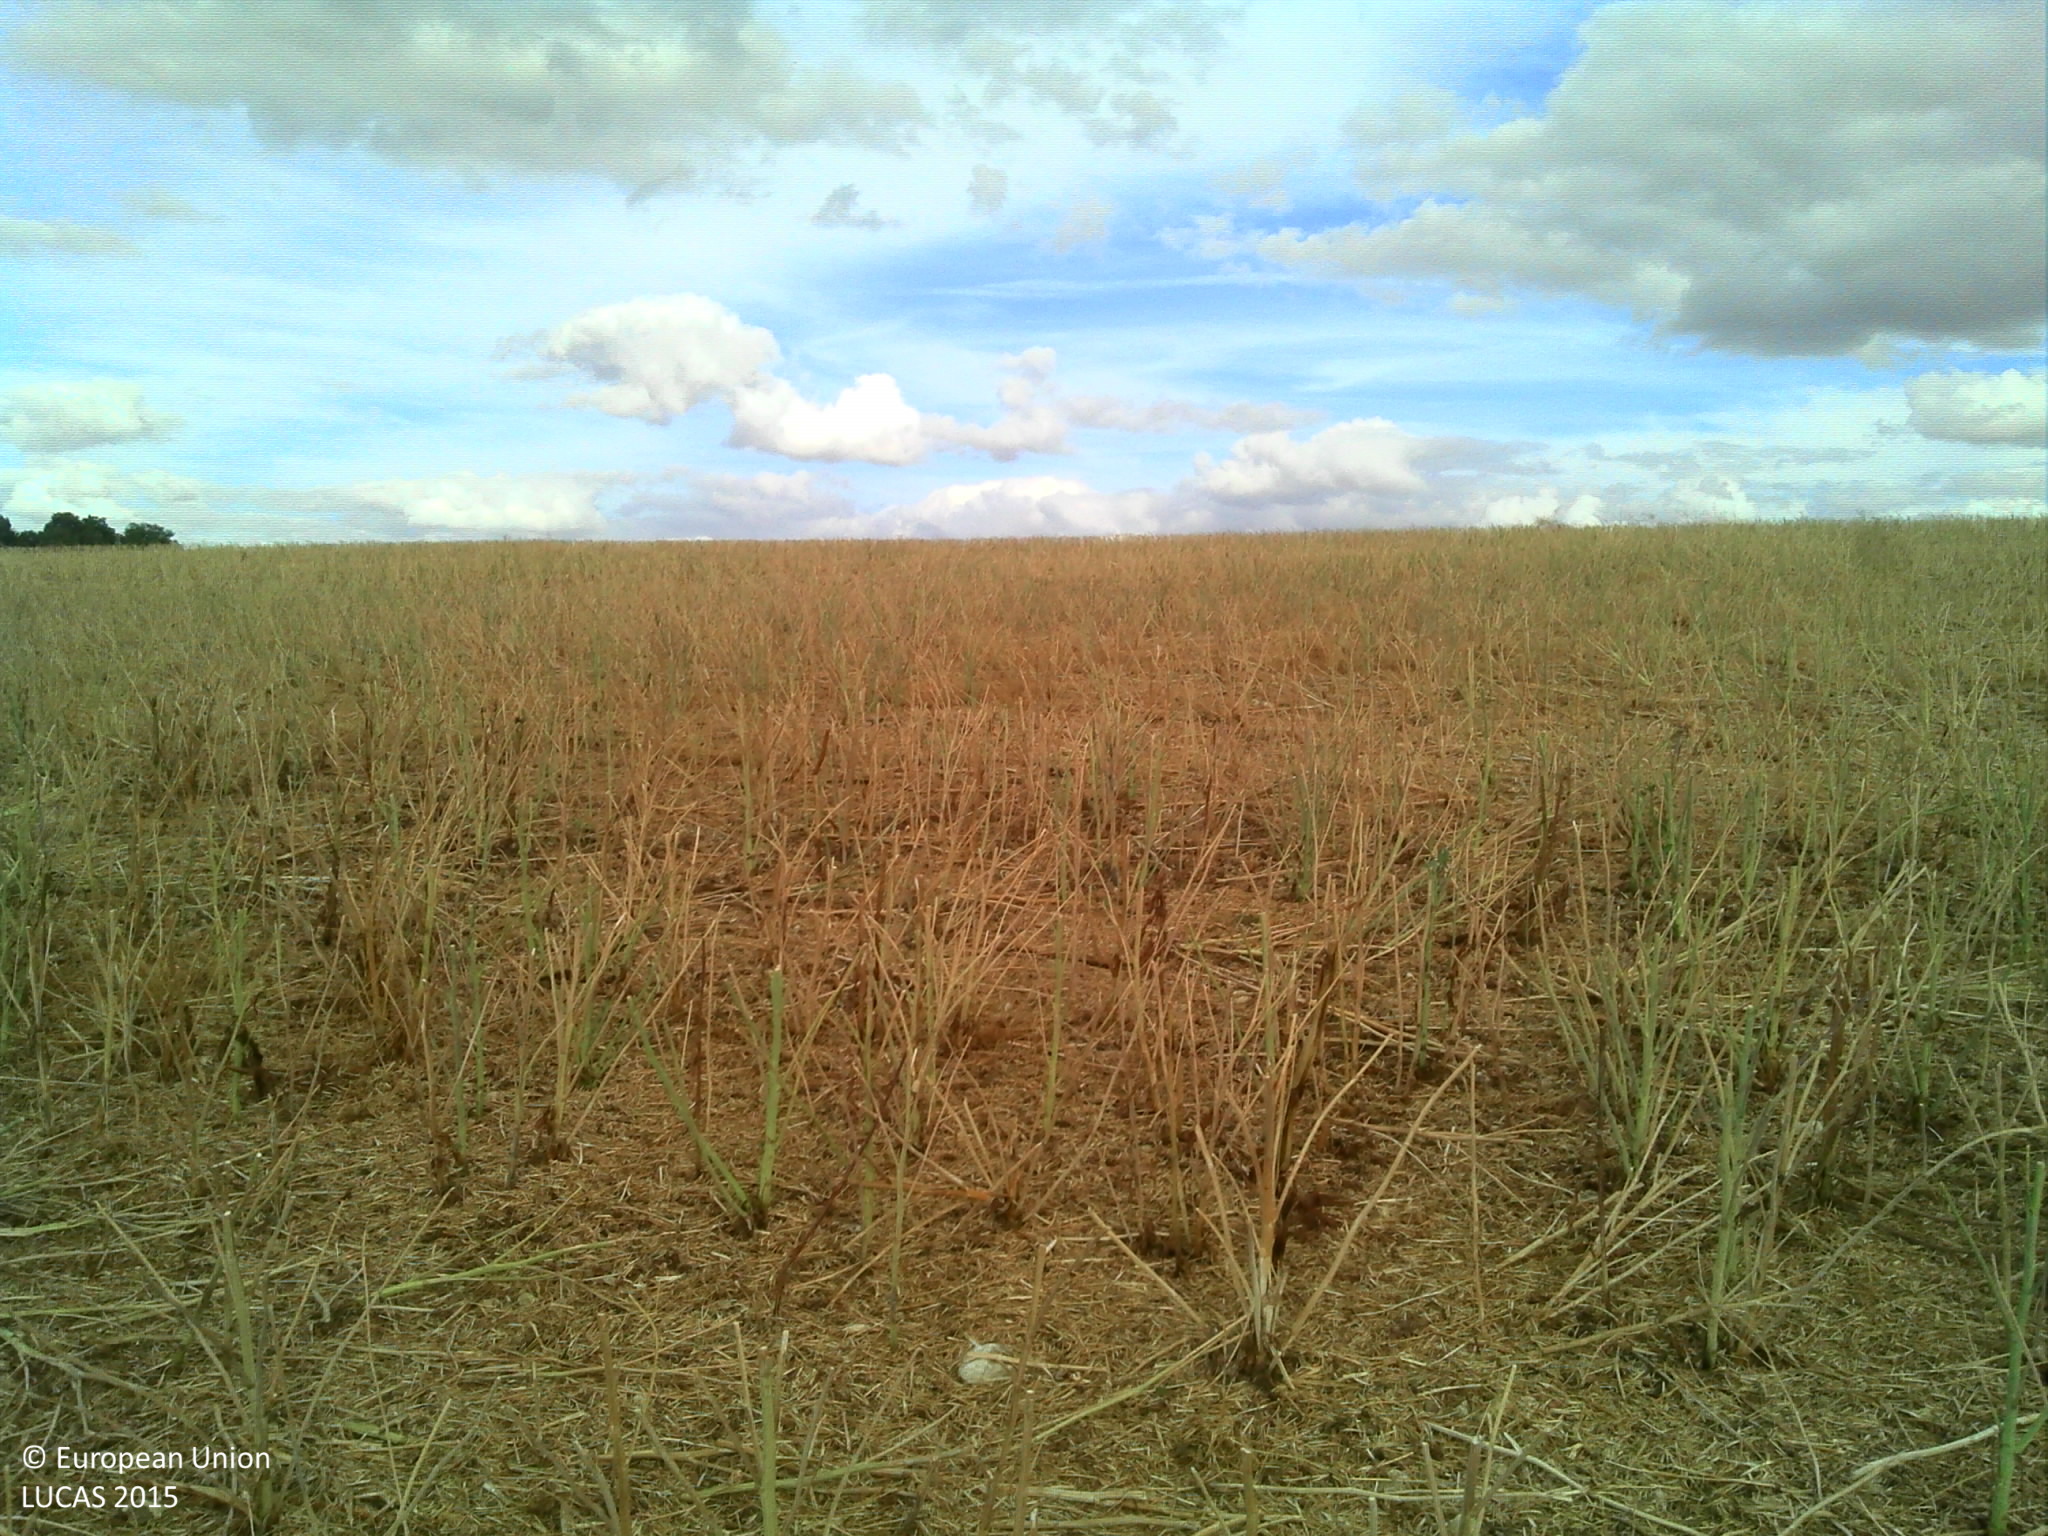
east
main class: Cropland
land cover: Rape and turnip rape
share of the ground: > 75 %
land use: Agriculture (excluding fallow land and kitchen gardens)
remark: Harvested field
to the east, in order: Rape and turnip rape; Tracks; Rape and turnip rape
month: July
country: FR
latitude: 47.9888
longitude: 1.3136
